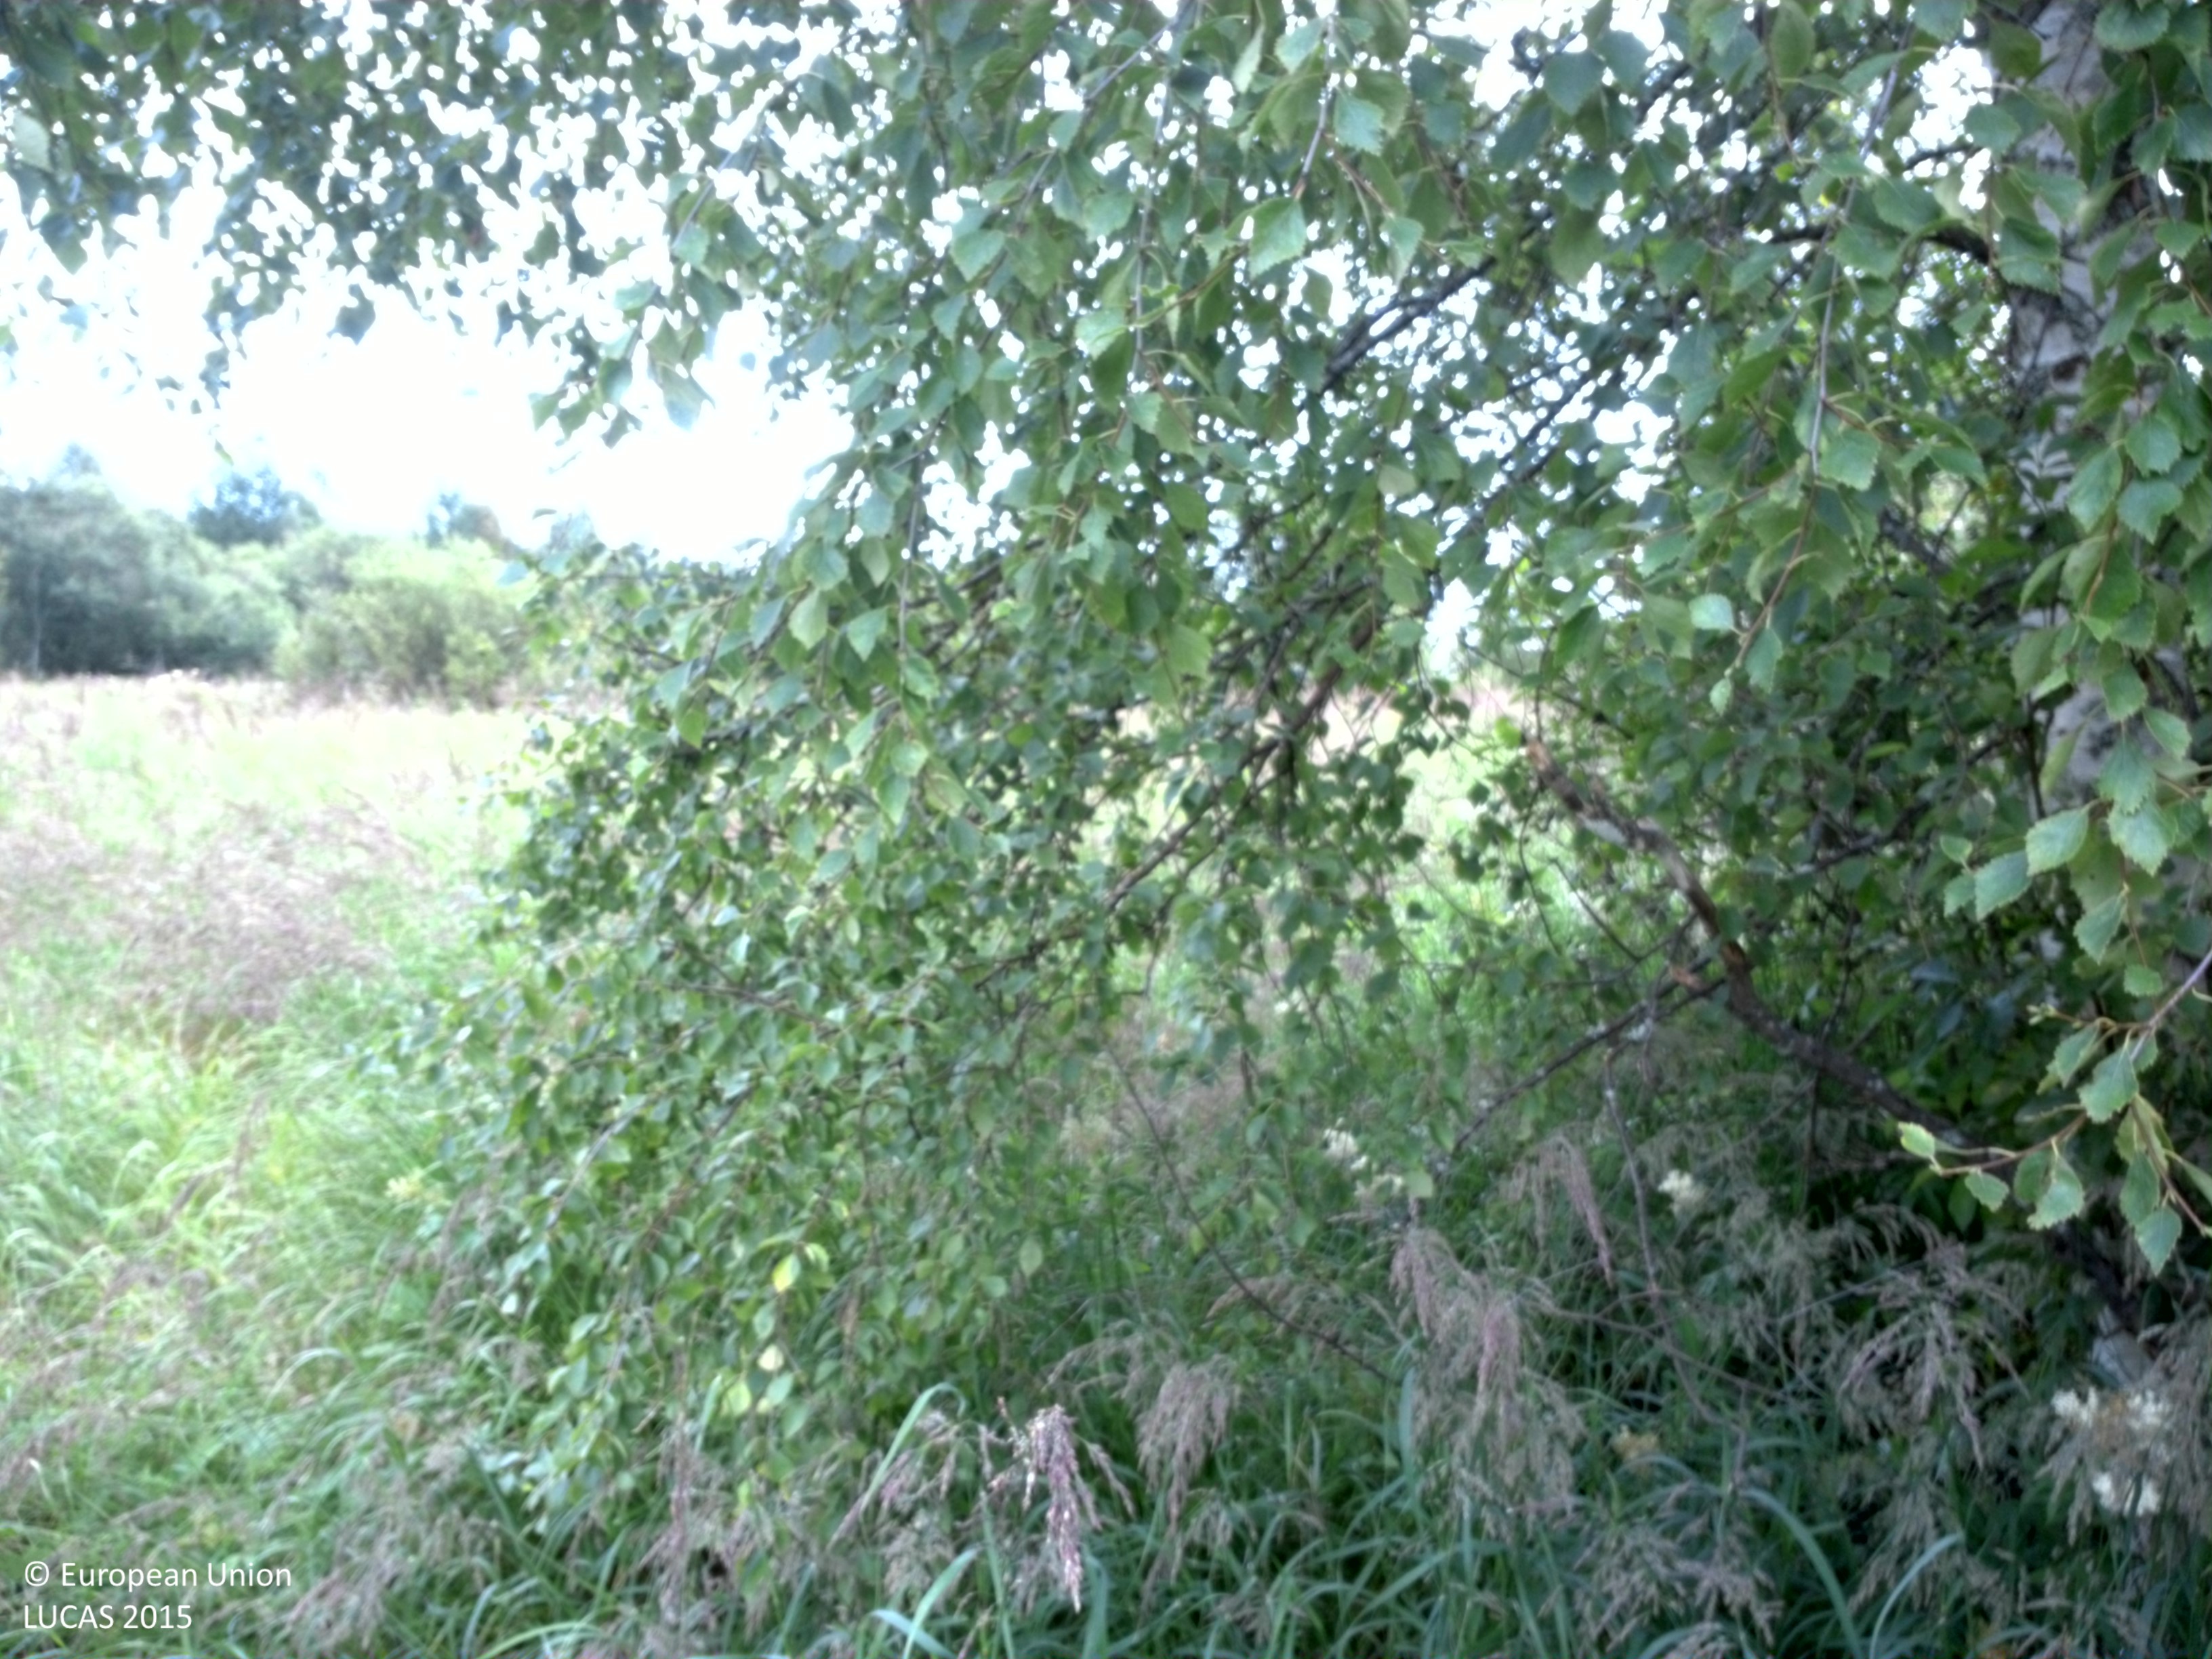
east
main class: Grassland
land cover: Grassland with sparse tree/shrub cover
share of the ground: > 75 %
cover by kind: herbaceous plants 95 %, broadleaved forest trees 5 %
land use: Agriculture (excluding fallow land and kitchen gardens)
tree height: > 5 m
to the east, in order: Grassland with sparse tree/shrub cover; Ditches and canals; Grassland with sparse tree/shrub cover; Ditches and canals; Grassland without tree/shrub cover; Broadleaved woodland; Ditches and canals; Broadleaved woodland; Grassland with sparse tree/shrub cover; Broadleaved woodland
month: August
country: SE
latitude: 64.6413
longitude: 20.9235
